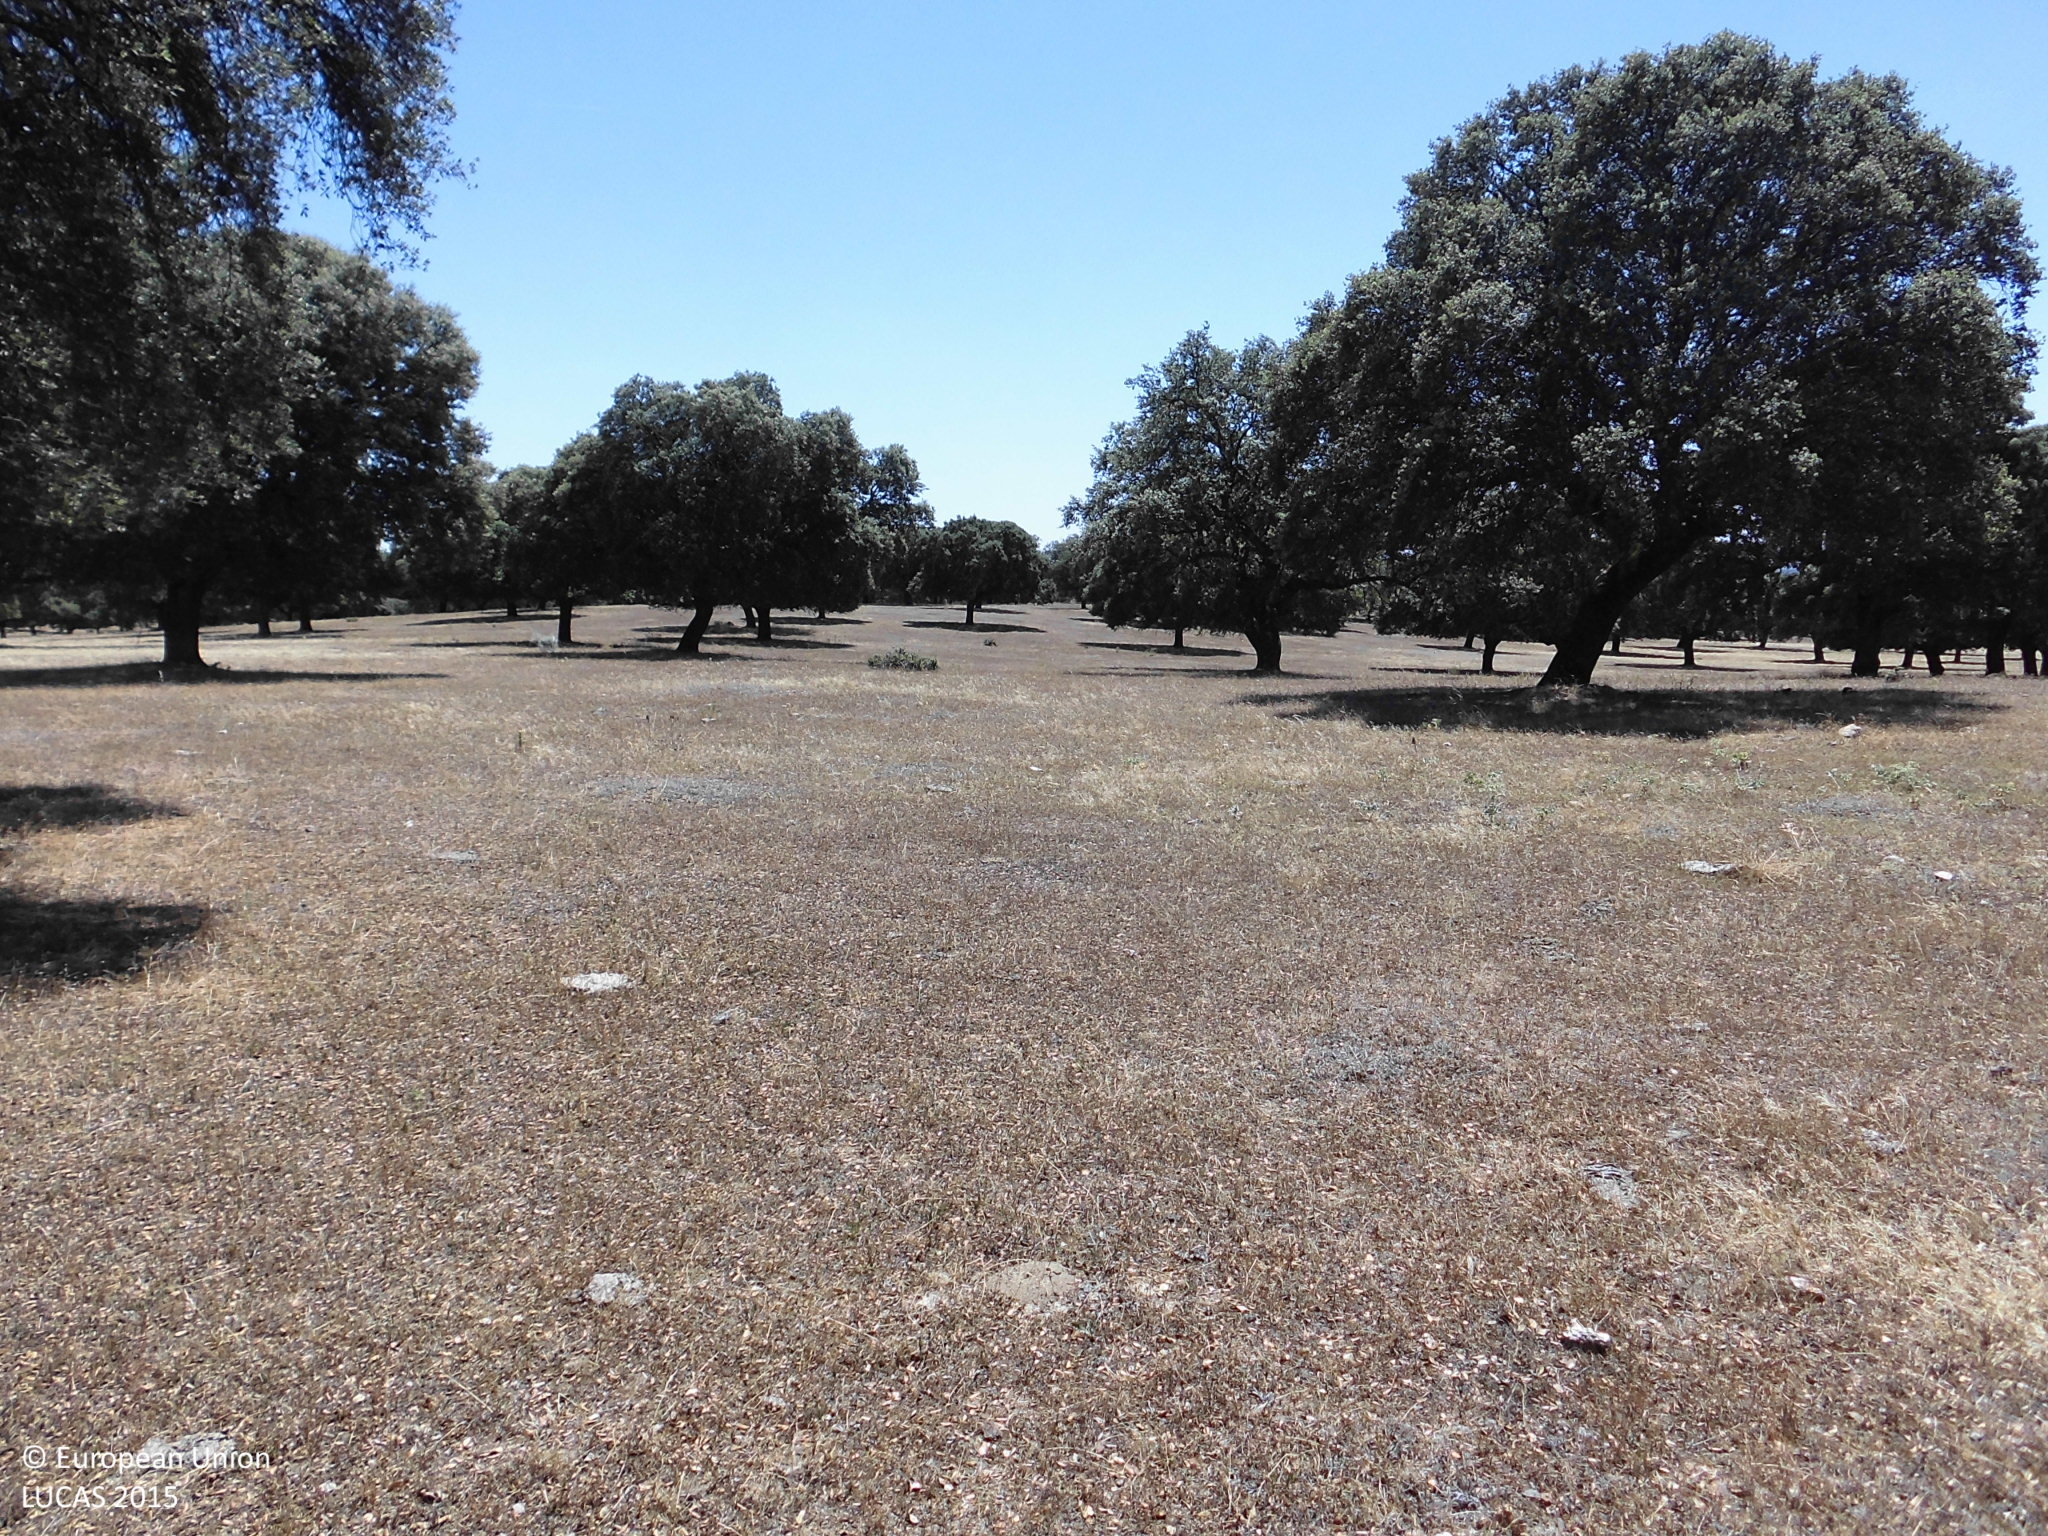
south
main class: Woodland
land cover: Broadleaved woodland
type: broadleaved evergreen forest
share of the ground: 10 - 25 %
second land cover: Grassland without tree/shrub cover
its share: > 75 %
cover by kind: herbaceous plants 80 %, broadleaved forest trees 20 %
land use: Forestry
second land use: Agriculture (excluding fallow land and kitchen gardens)
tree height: > 5 m
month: June
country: ES
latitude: 39.9729
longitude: -6.1238
